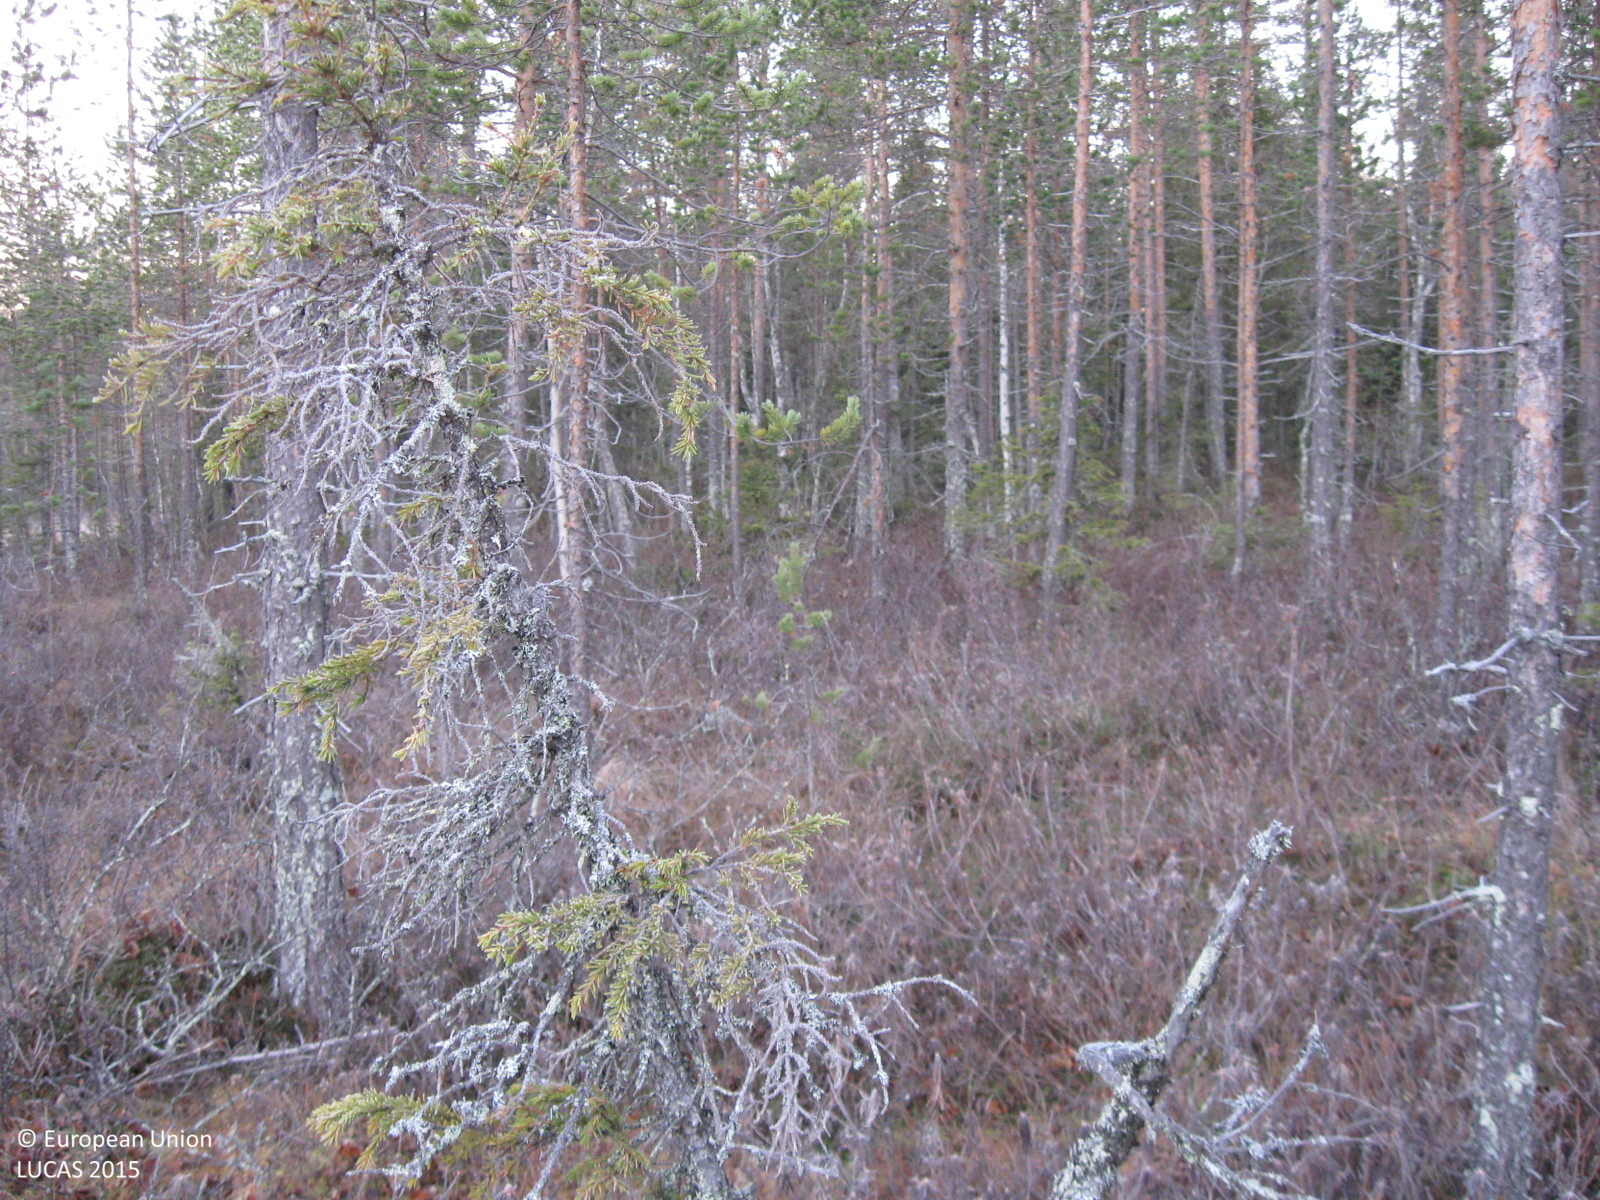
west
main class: Woodland
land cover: Pine dominated coniferous woodland
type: mire and swamp forests
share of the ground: 50 - 75 %
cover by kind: coniferous forest trees 45 %, shrubs 25 %, herbaceous plants 15 %, broadleaved forest trees 10 %, lichens and mosses 5 %
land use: Semi-natural and natural areas not in use
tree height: > 5 m
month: October
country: SE
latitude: 66.1488
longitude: 22.1397
